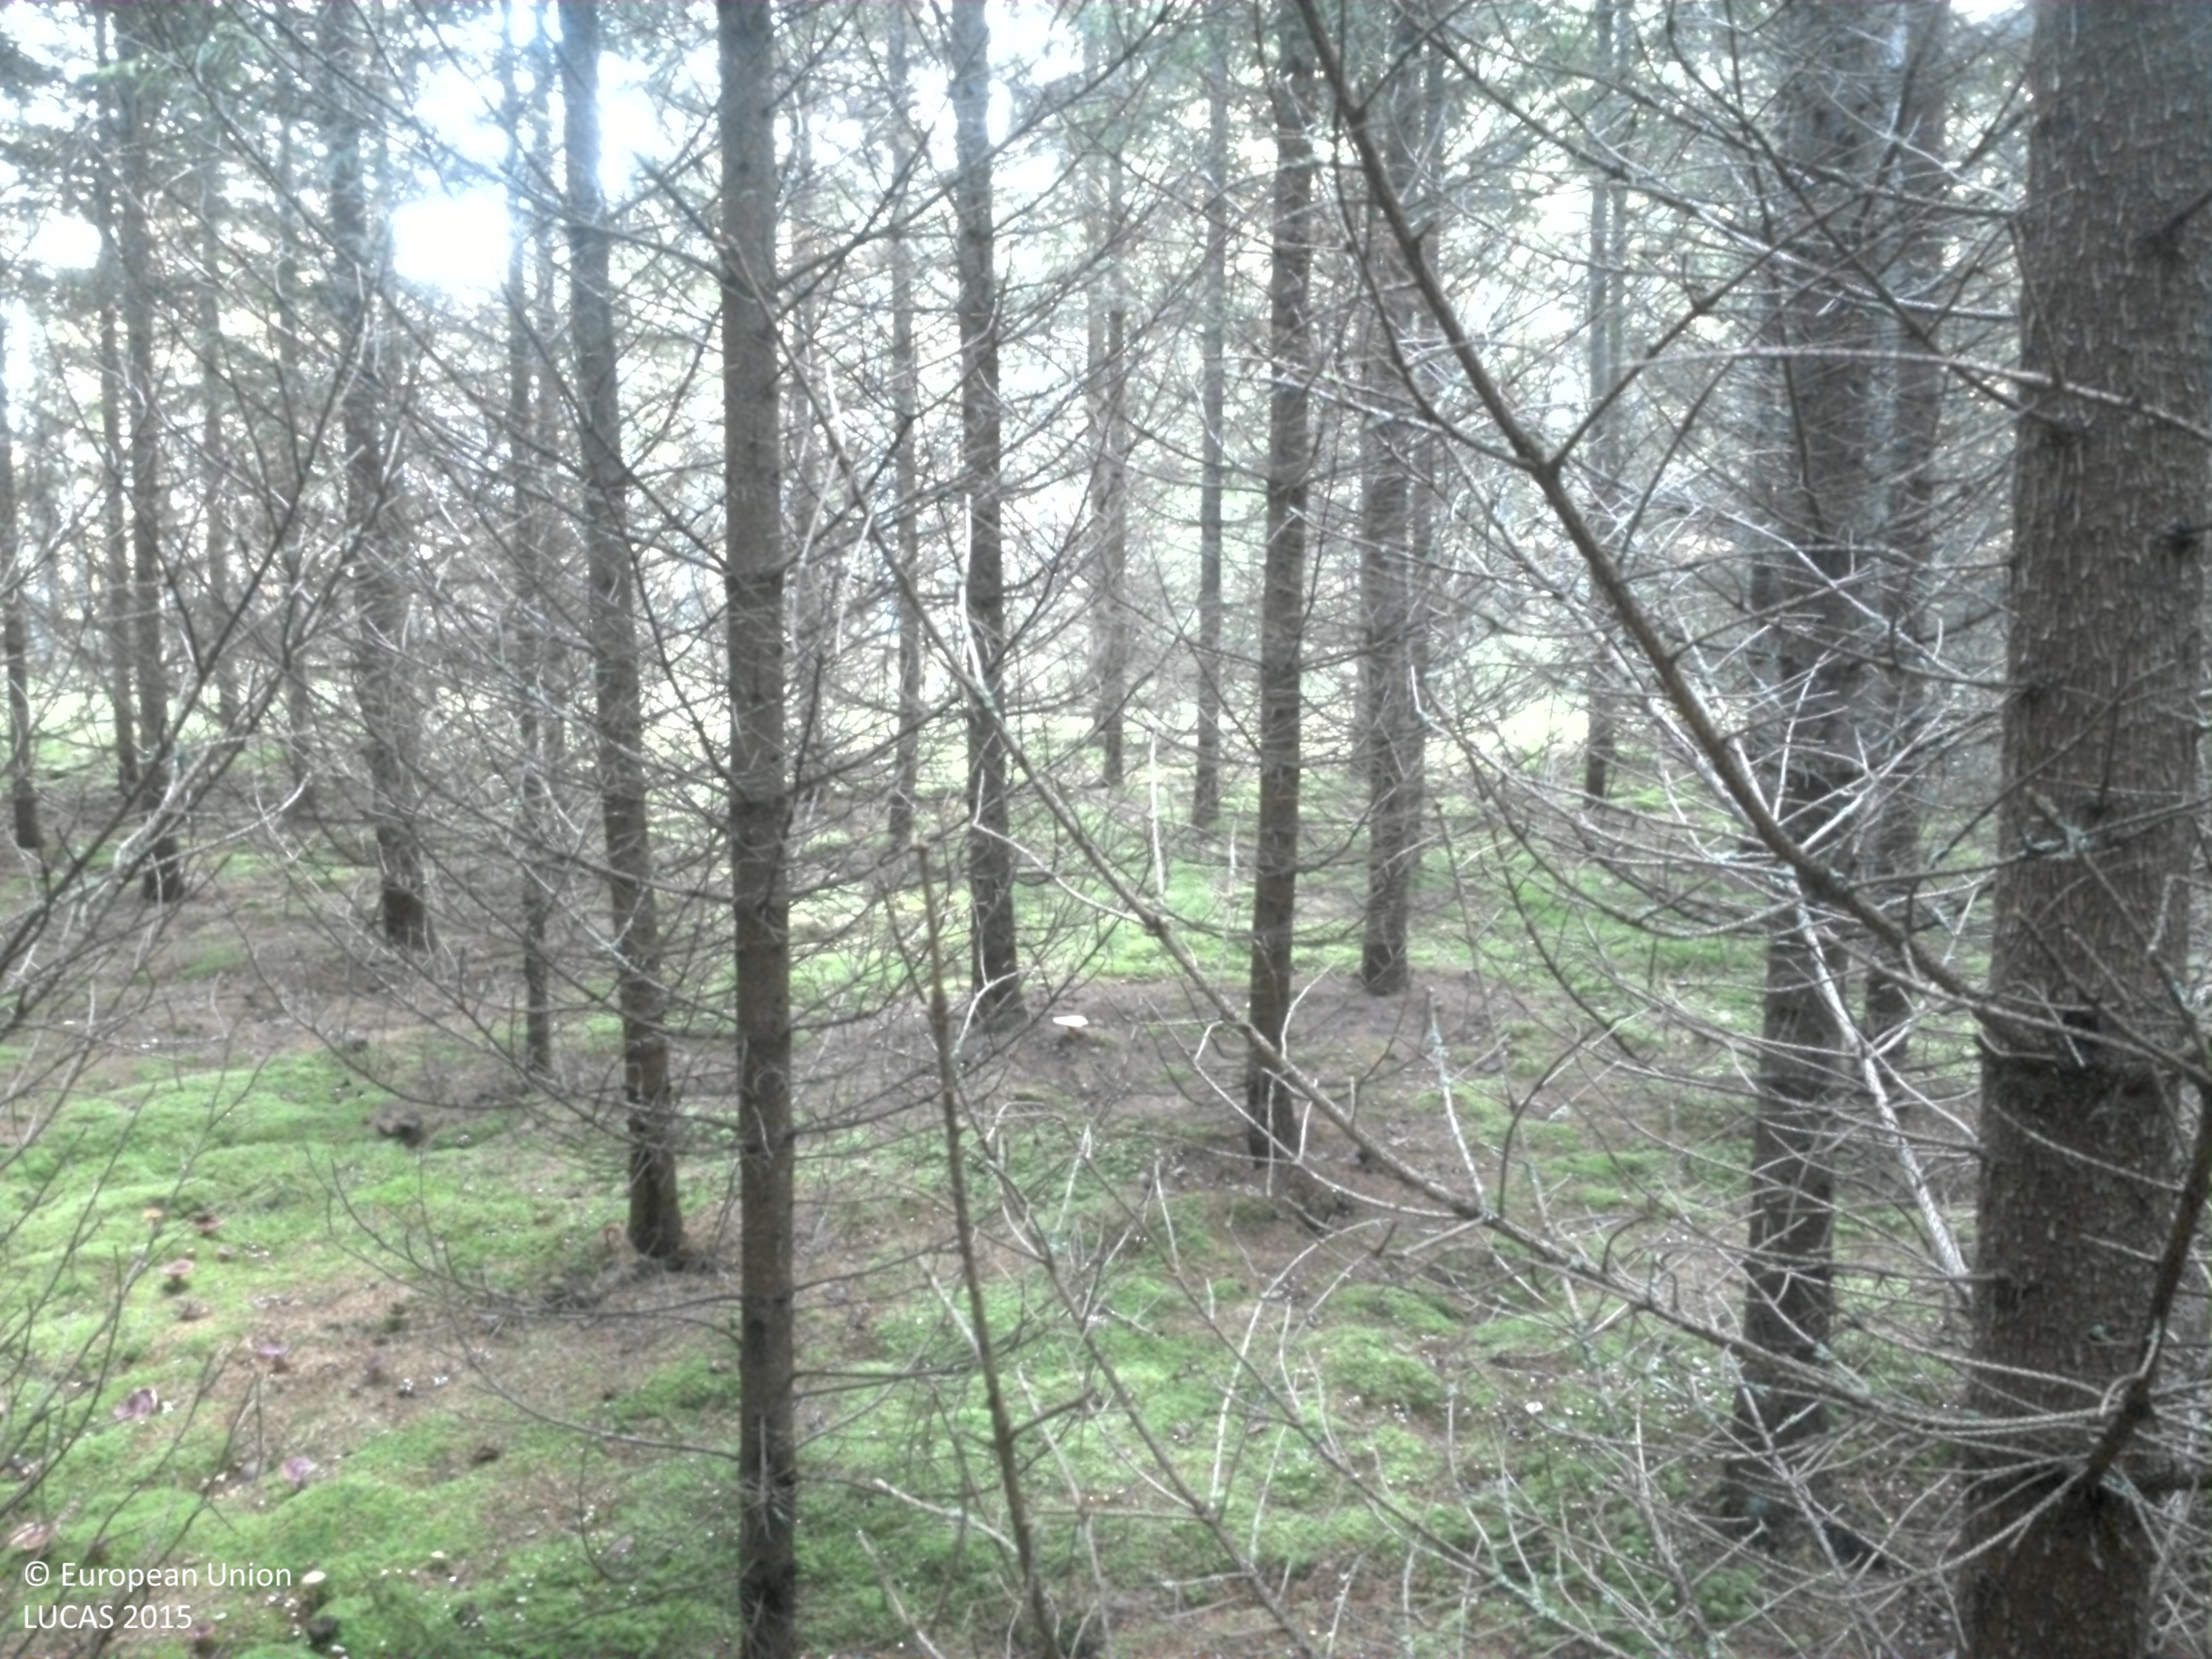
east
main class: Woodland
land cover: Spruce dominated coniferous woodland
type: boreal forest
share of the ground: > 75 %
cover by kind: coniferous forest trees 85 %, lichens and mosses 15 %
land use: Forestry
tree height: > 5 m
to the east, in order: Spruce dominated coniferous woodland; Other mixed woodland; Spruce dominated mixed woodland; Tracks; Spruce dominated mixed woodland; Spruce dominated coniferous woodland; Grassland with sparse tree/shrub cover
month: September
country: SE
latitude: 59.4800
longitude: 15.4462
